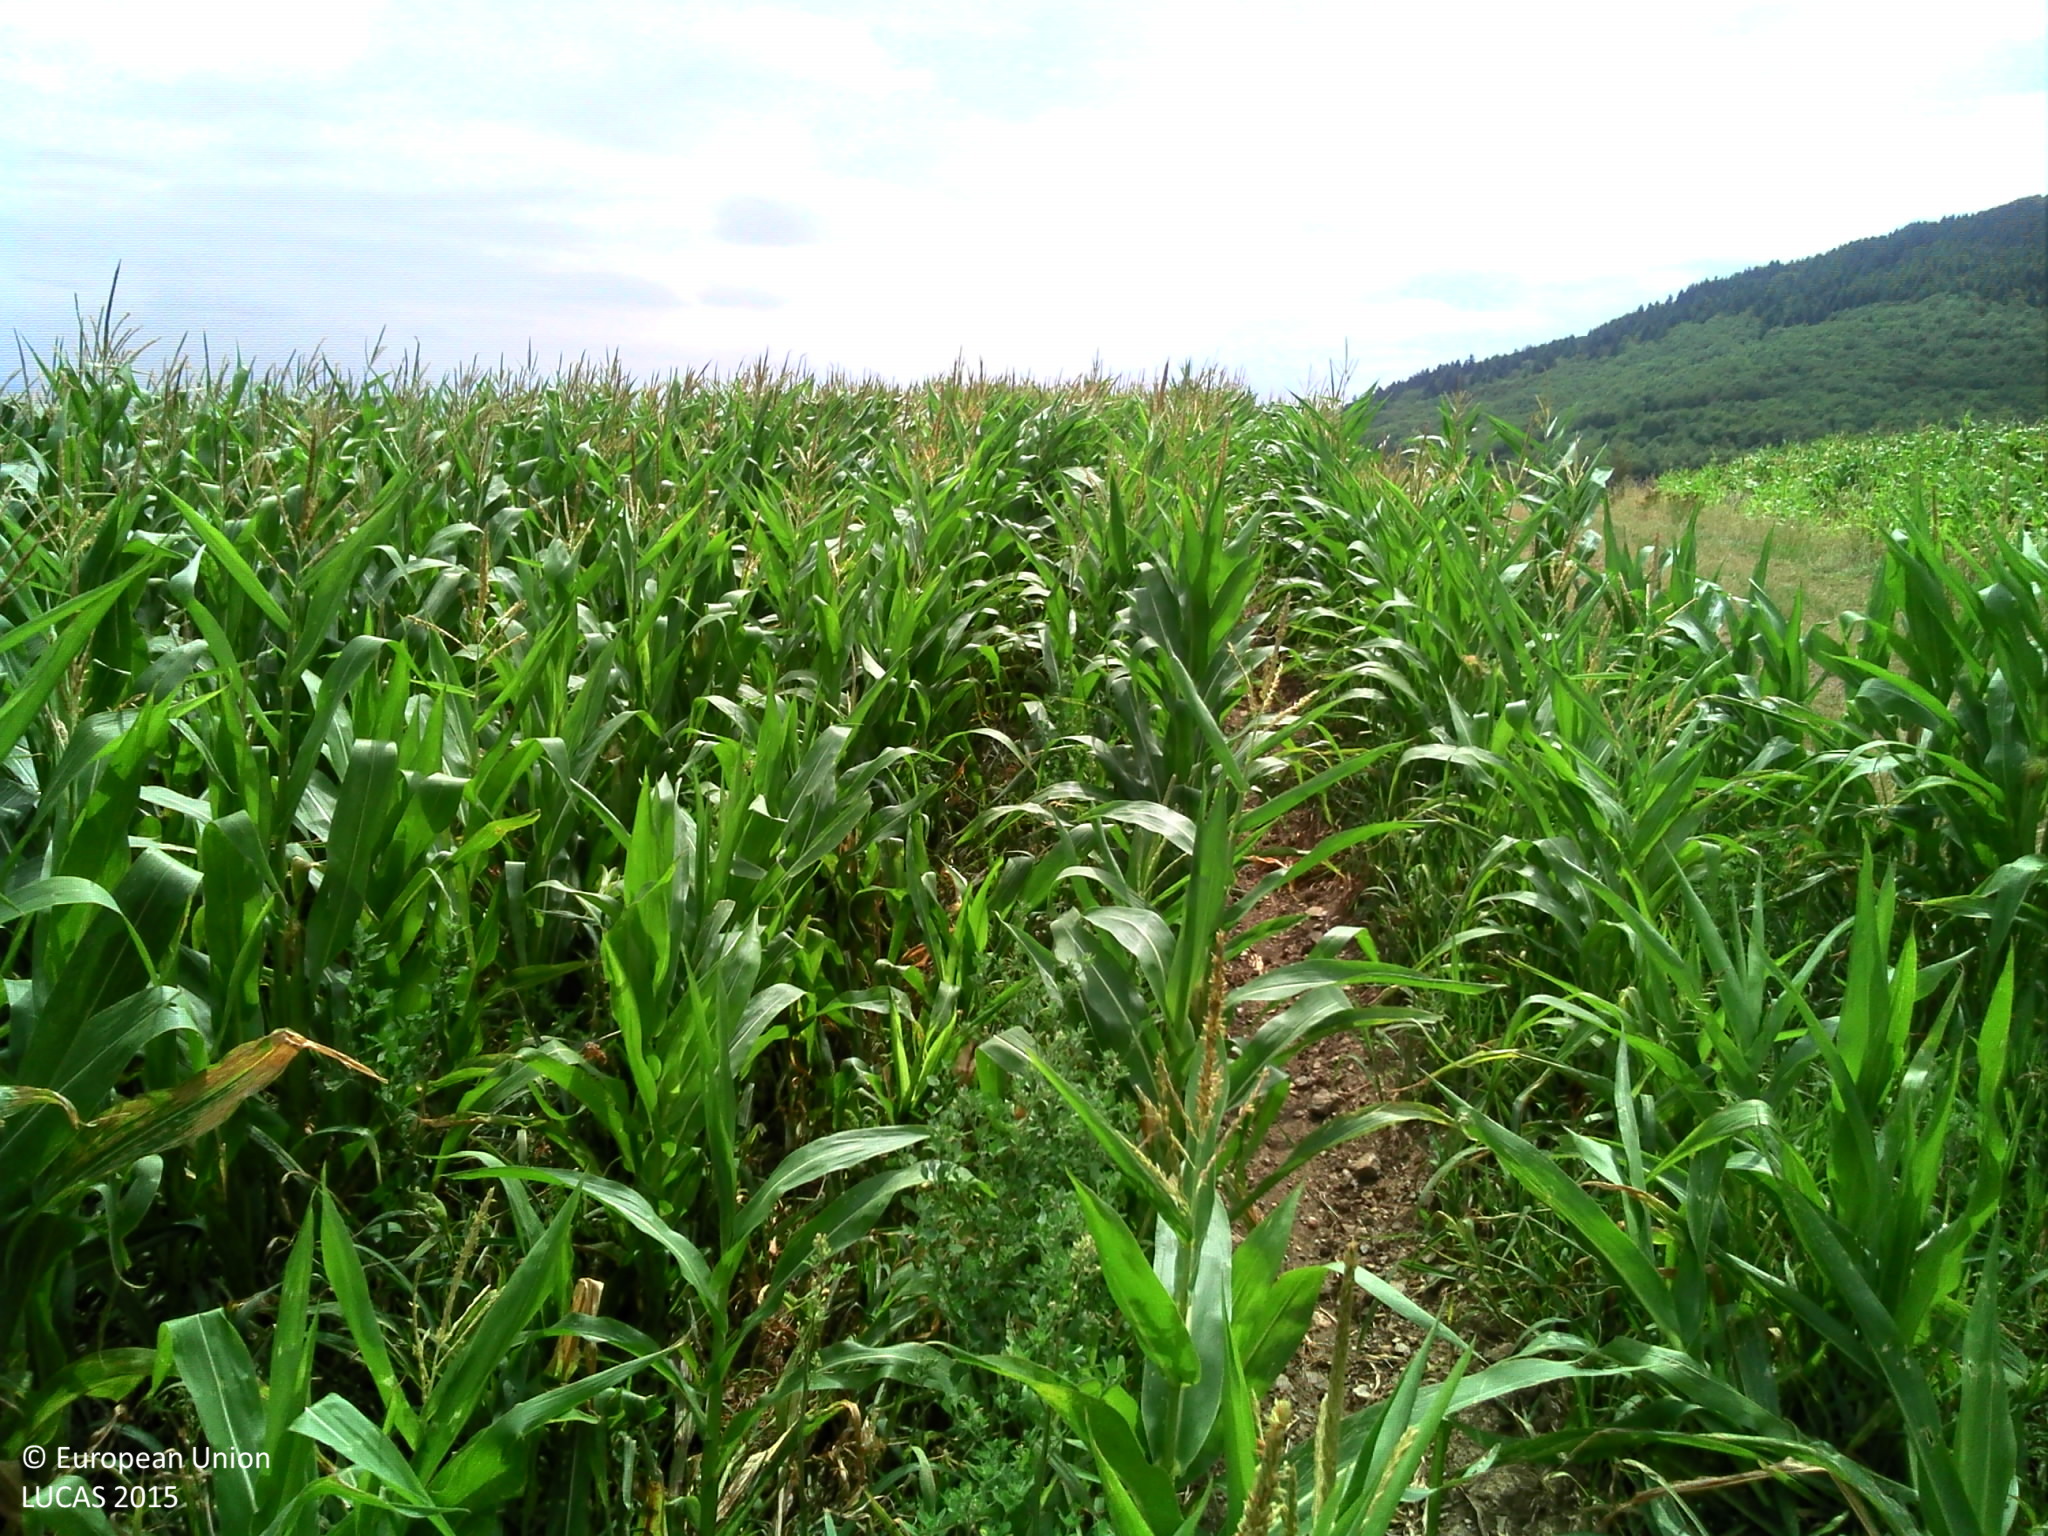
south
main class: Cropland
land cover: Maize
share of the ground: > 75 %
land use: Agriculture (excluding fallow land and kitchen gardens)
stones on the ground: 25 - 50 %
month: August
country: FR
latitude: 45.4986
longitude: 4.7188
